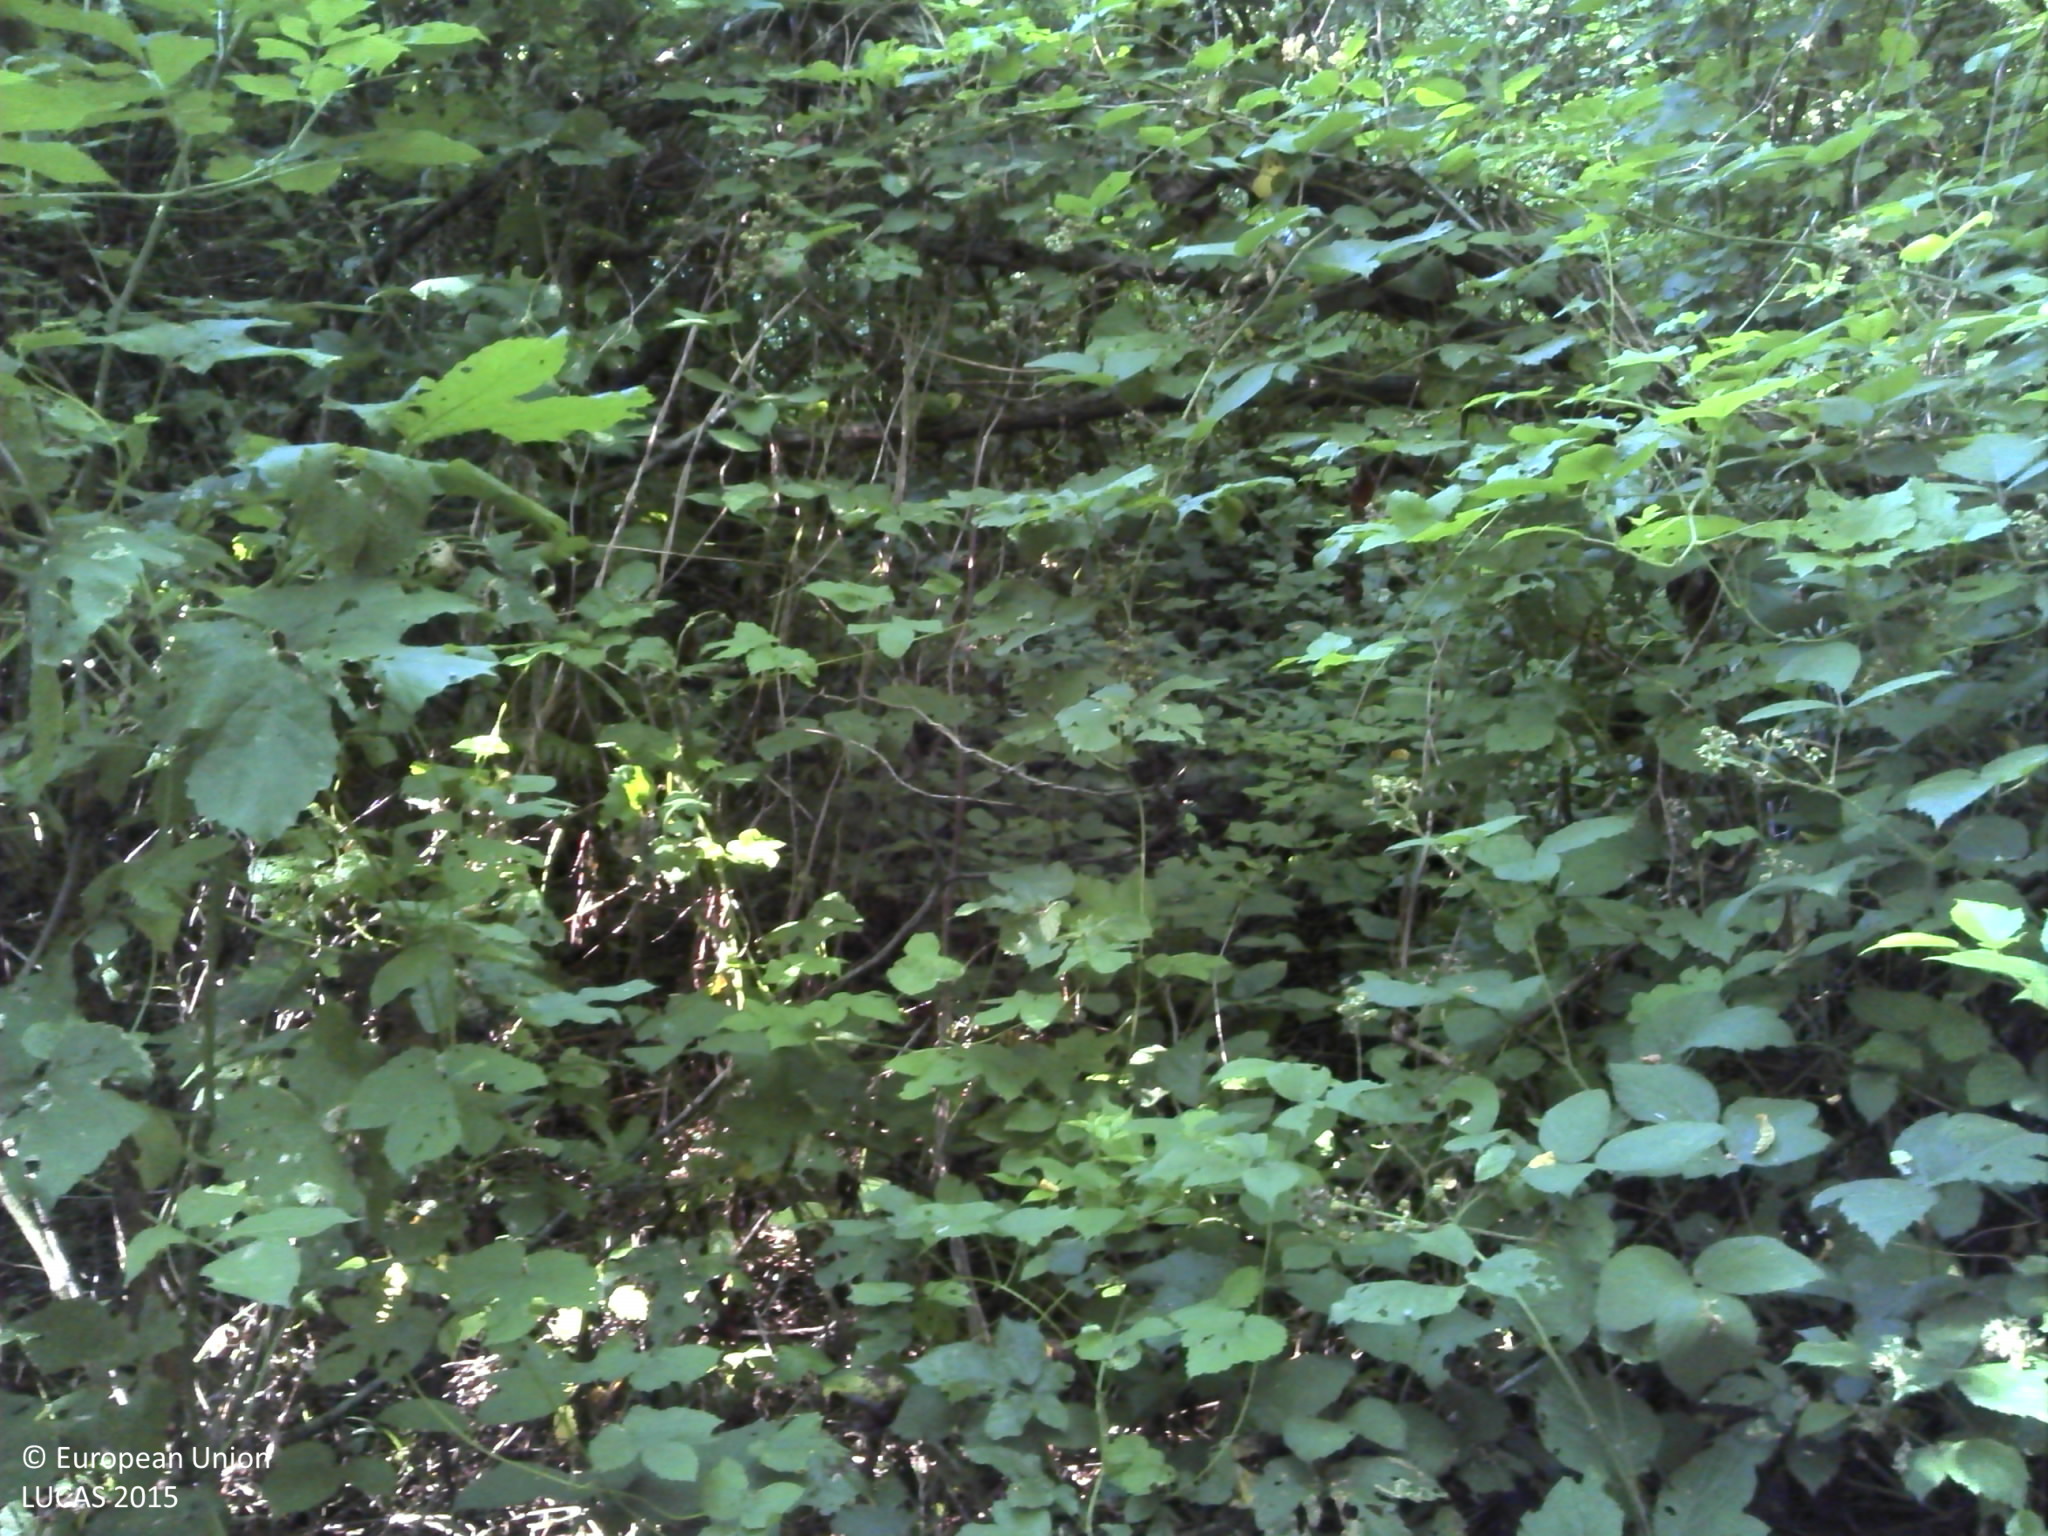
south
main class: Woodland
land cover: Broadleaved woodland
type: acidophilous oak and oak-birch forest
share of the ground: > 75 %
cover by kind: broadleaved forest trees 100 %
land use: Forestry
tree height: > 5 m
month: June
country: HR
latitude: 45.2802
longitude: 17.4070
